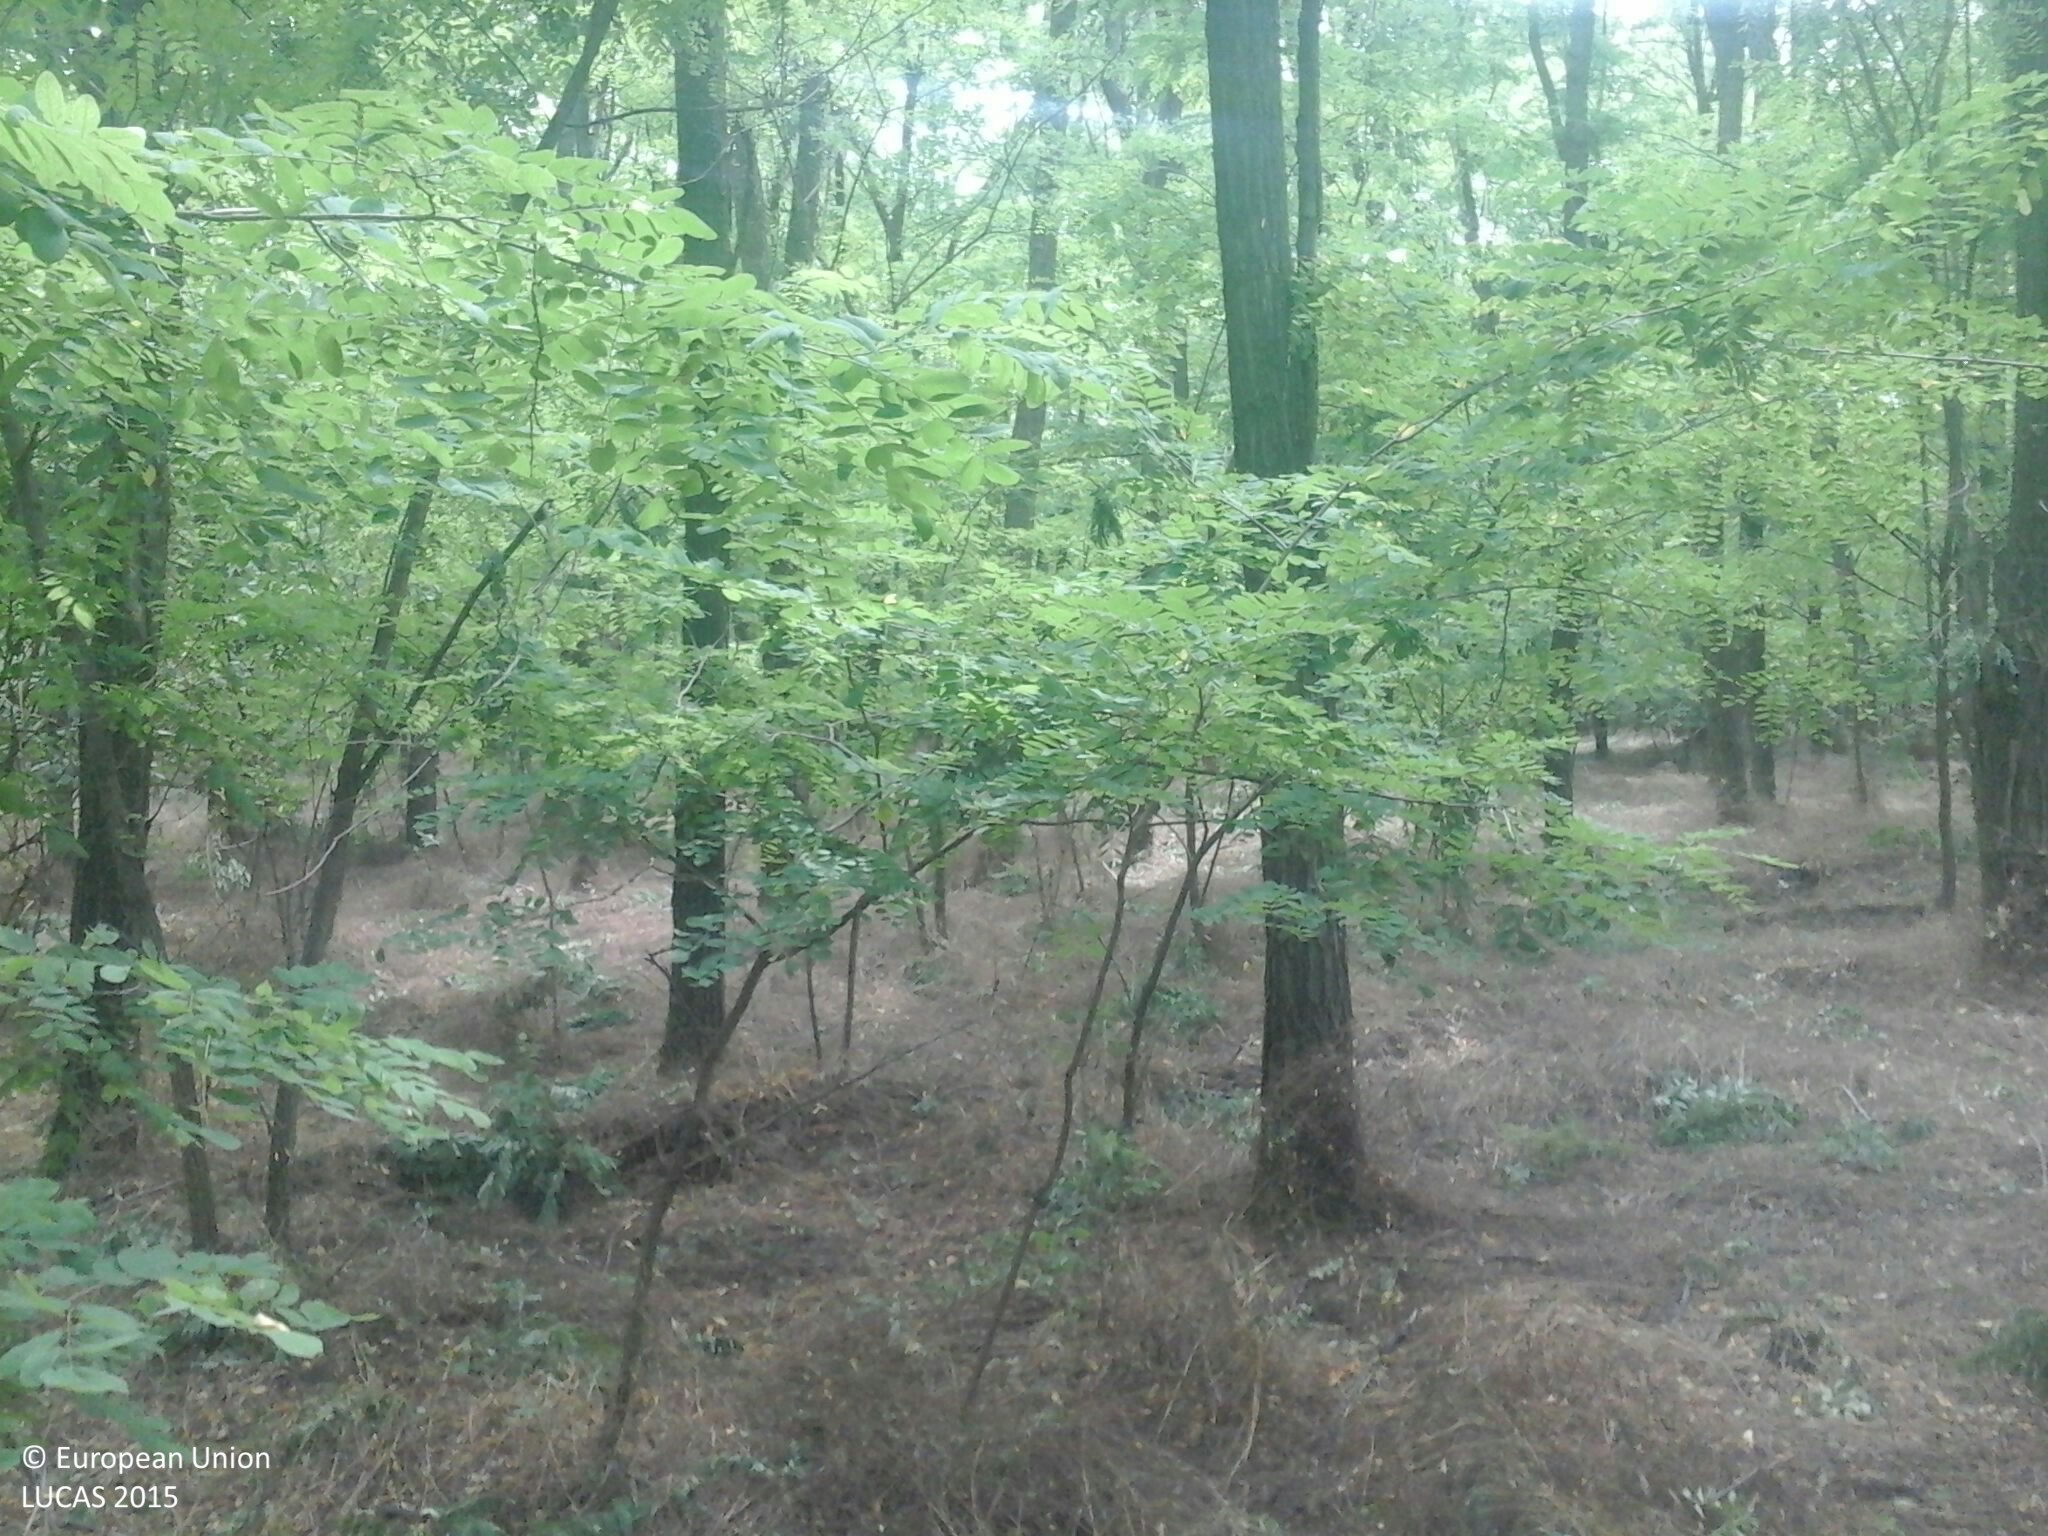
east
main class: Woodland
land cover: Broadleaved woodland
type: mesophytic deciduous forest
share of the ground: > 75 %
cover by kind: broadleaved forest trees 95 %, herbaceous plants 5 %
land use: Forestry
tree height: > 5 m
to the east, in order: Broadleaved woodland
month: July
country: HU
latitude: 47.2114
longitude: 19.3272
